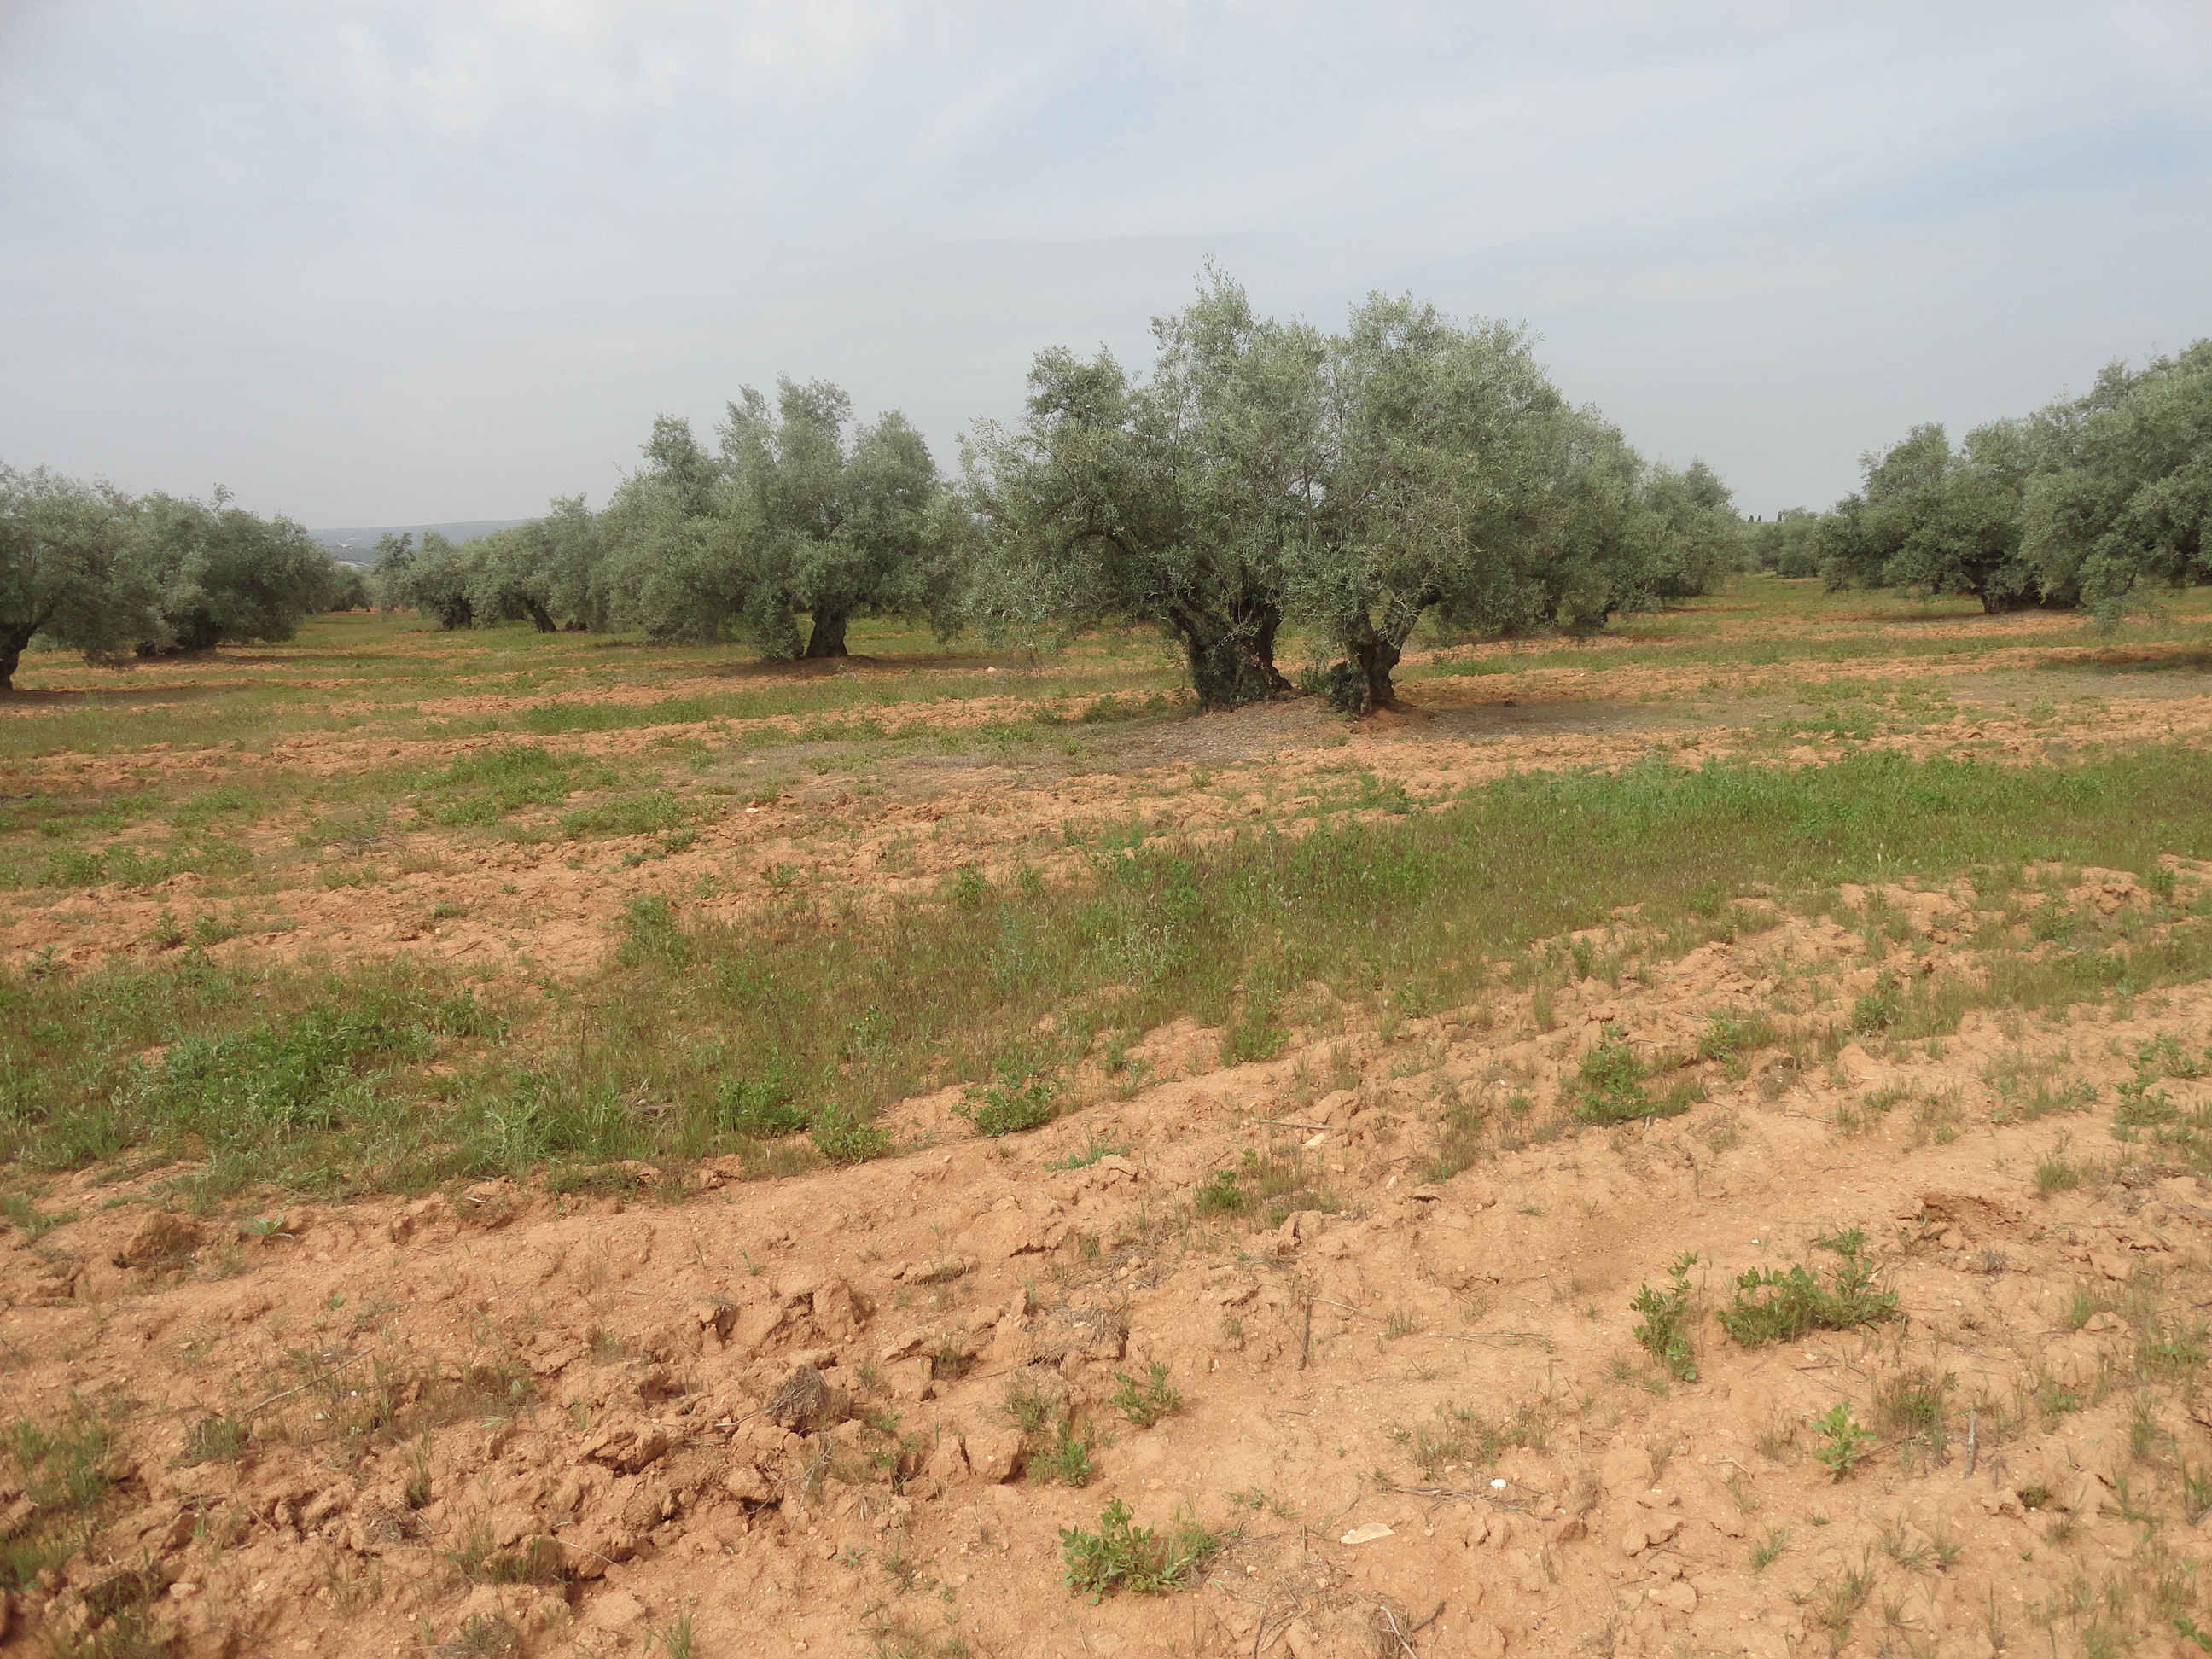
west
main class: Cropland
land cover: Olive groves
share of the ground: 25 - 50 %
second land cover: Spontaneously vegetated surfaces
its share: 50 - 75 %
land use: Agriculture (excluding fallow land and kitchen gardens)
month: April
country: ES
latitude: 37.5204
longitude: -4.5674
